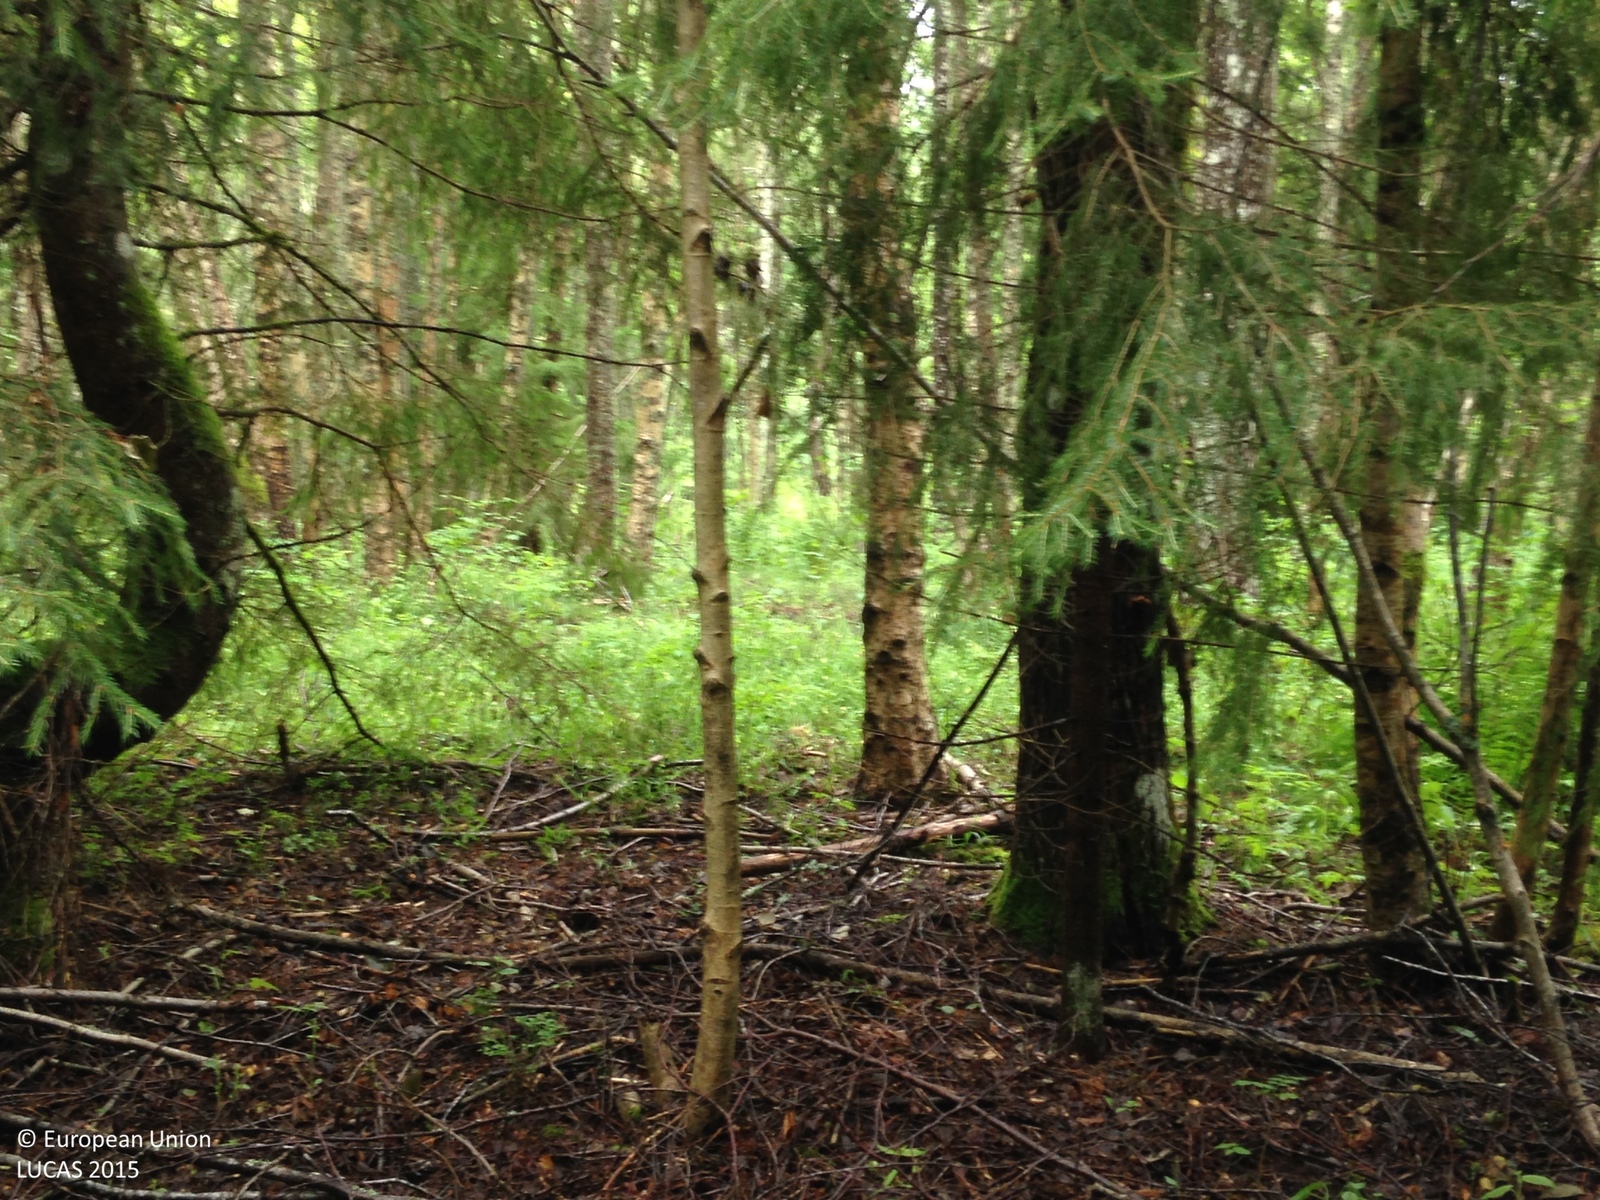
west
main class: Woodland
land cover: Spruce dominated mixed woodland
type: boreal forest
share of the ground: 50 - 75 %
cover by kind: coniferous forest trees 30 %, broadleaved forest trees 30 %, herbaceous plants 25 %, consolidated bare surface 10 %, shrubs 5 %
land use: Forestry
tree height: > 5 m
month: July
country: SE
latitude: 58.9239
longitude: 14.3521
